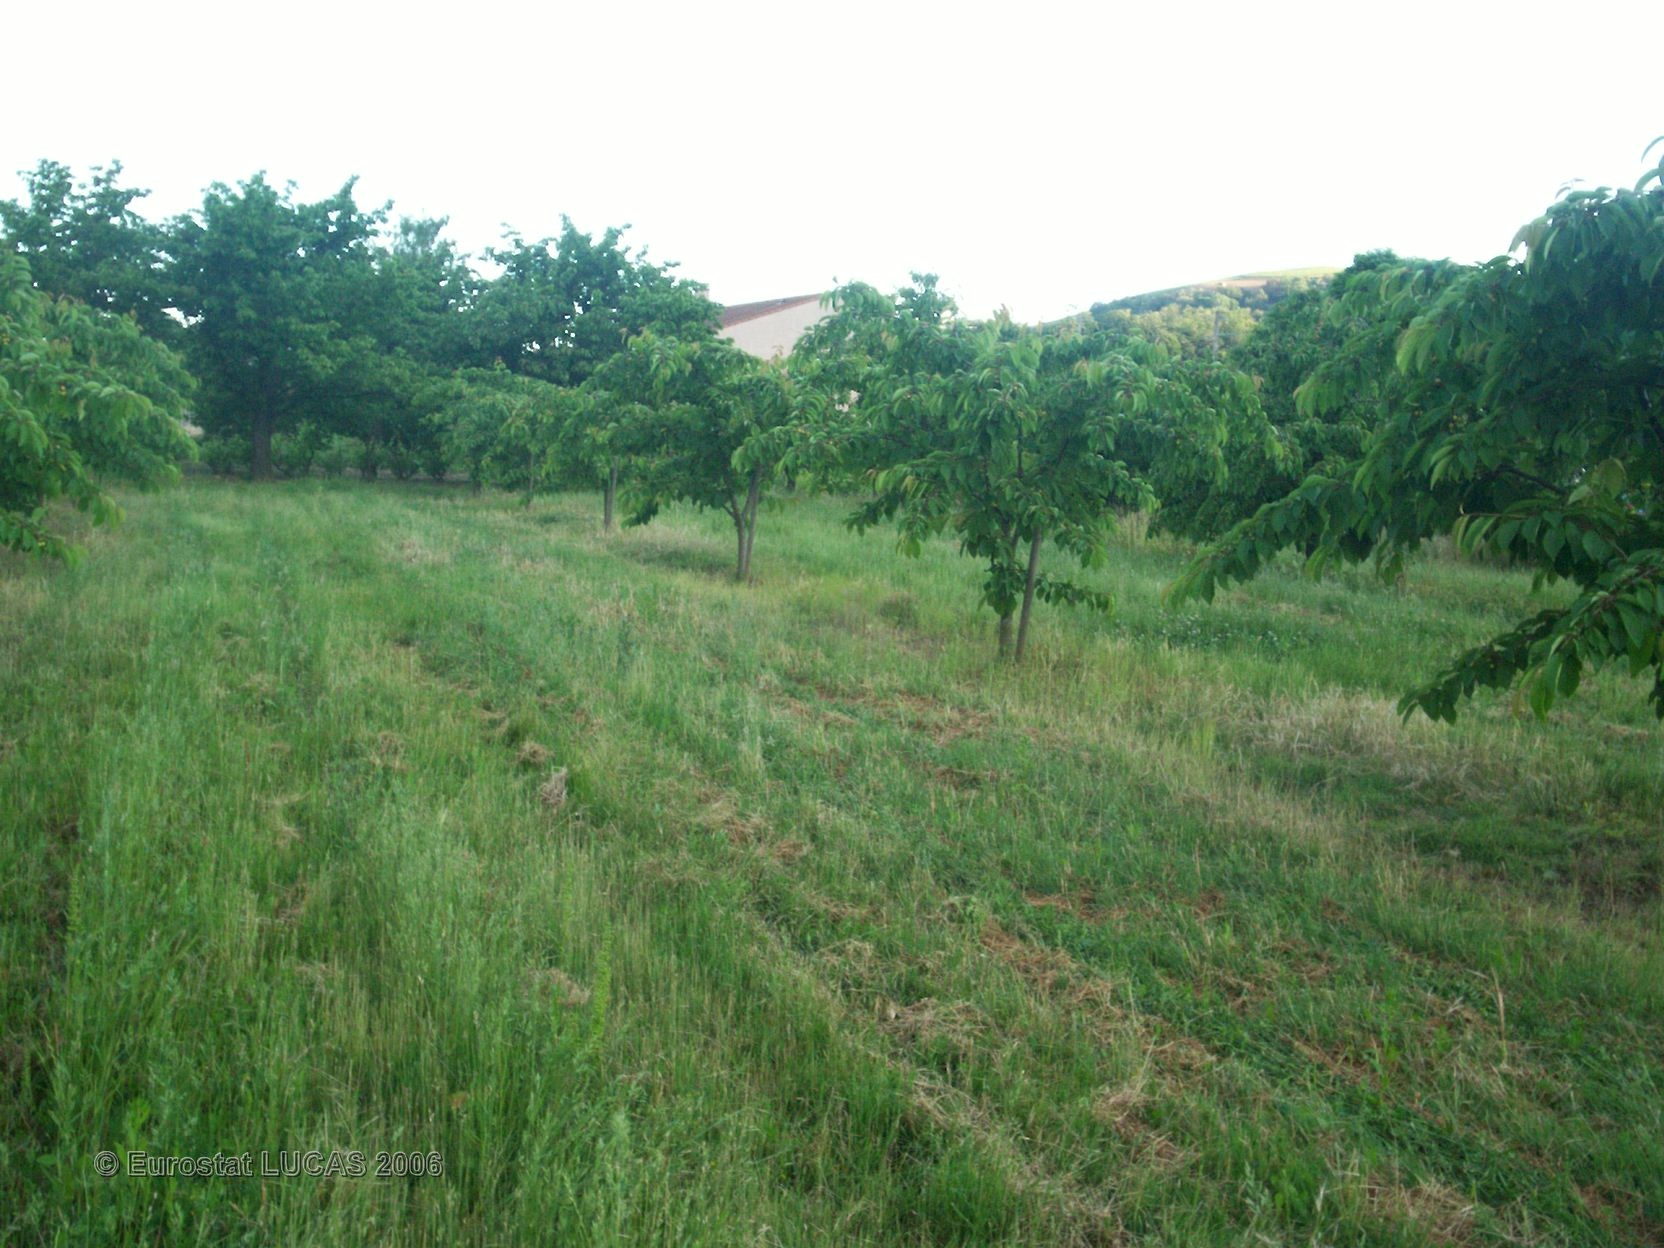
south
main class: Cropland
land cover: Cherry fruit
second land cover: Grassland with sparse tree/shrub cover
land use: Agriculture (excluding fallow land and kitchen gardens)
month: May
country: FR
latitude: 45.3561
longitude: 4.7580
